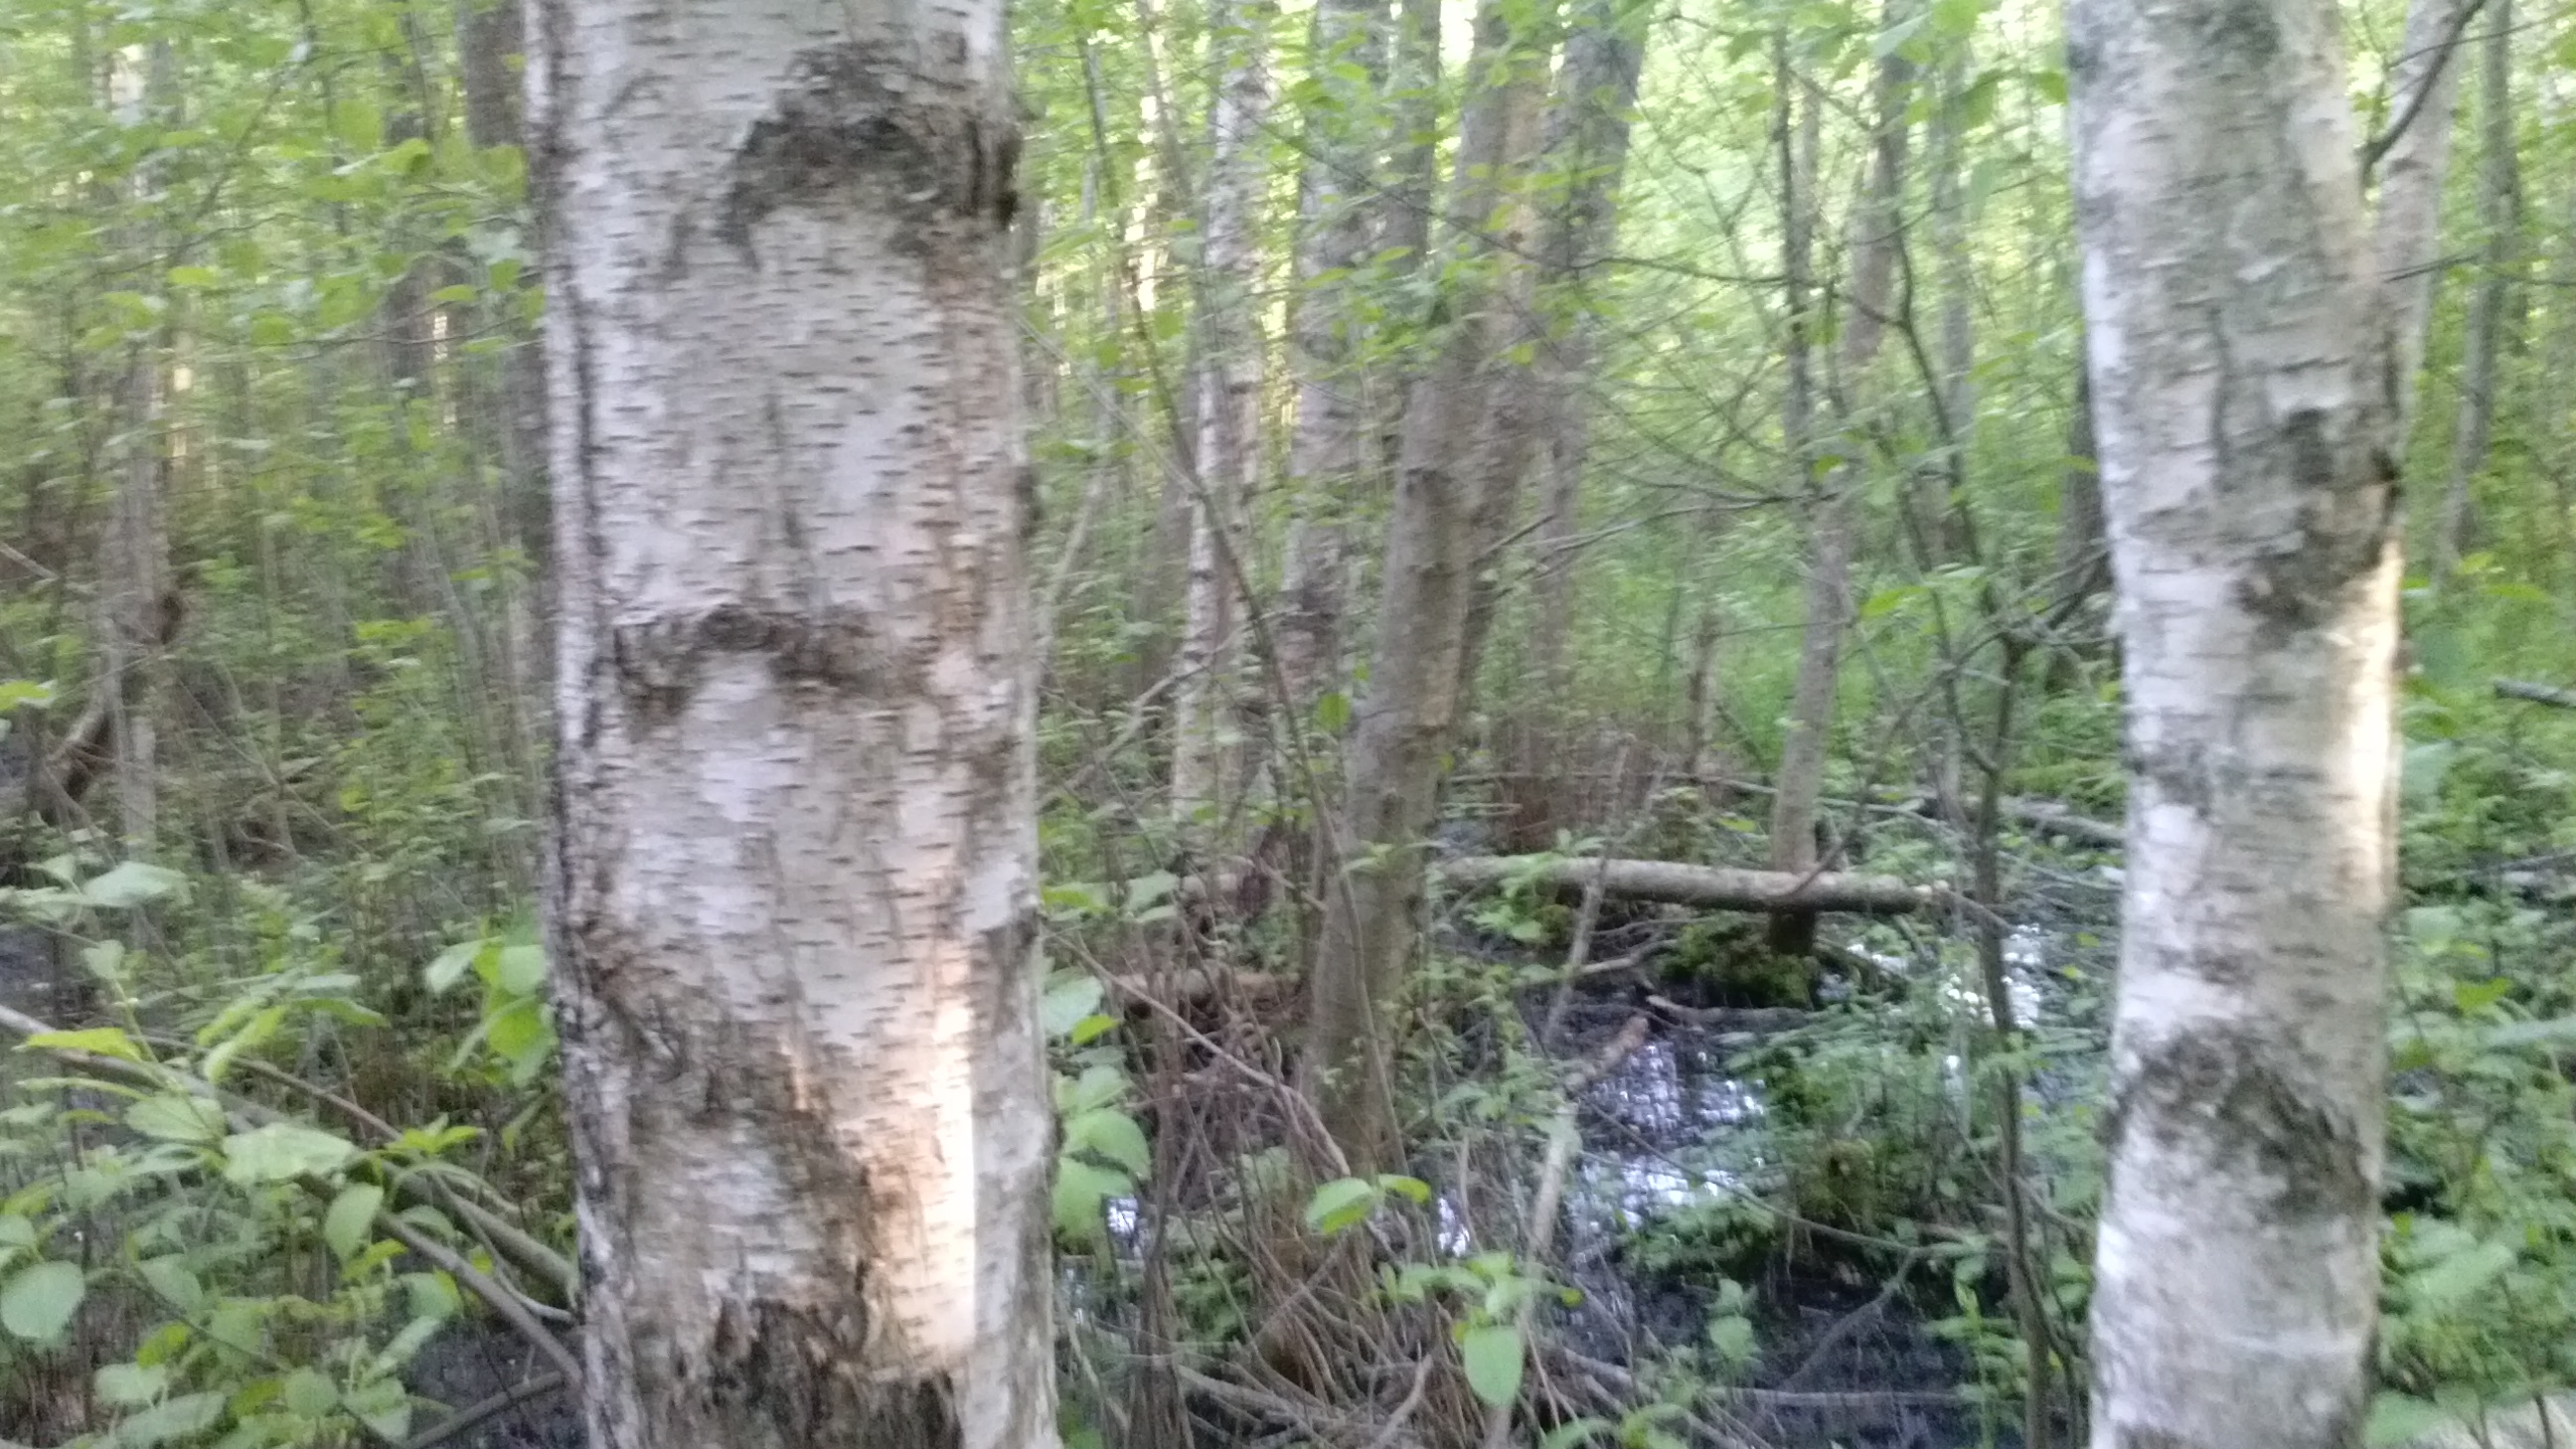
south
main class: Woodland
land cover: Broadleaved woodland
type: non-riverine alder, birch or aspen forest
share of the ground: > 75 %
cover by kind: broadleaved forest trees 100 %
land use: Forestry
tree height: > 5 m
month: June
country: LV
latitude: 56.3133
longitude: 27.9289
